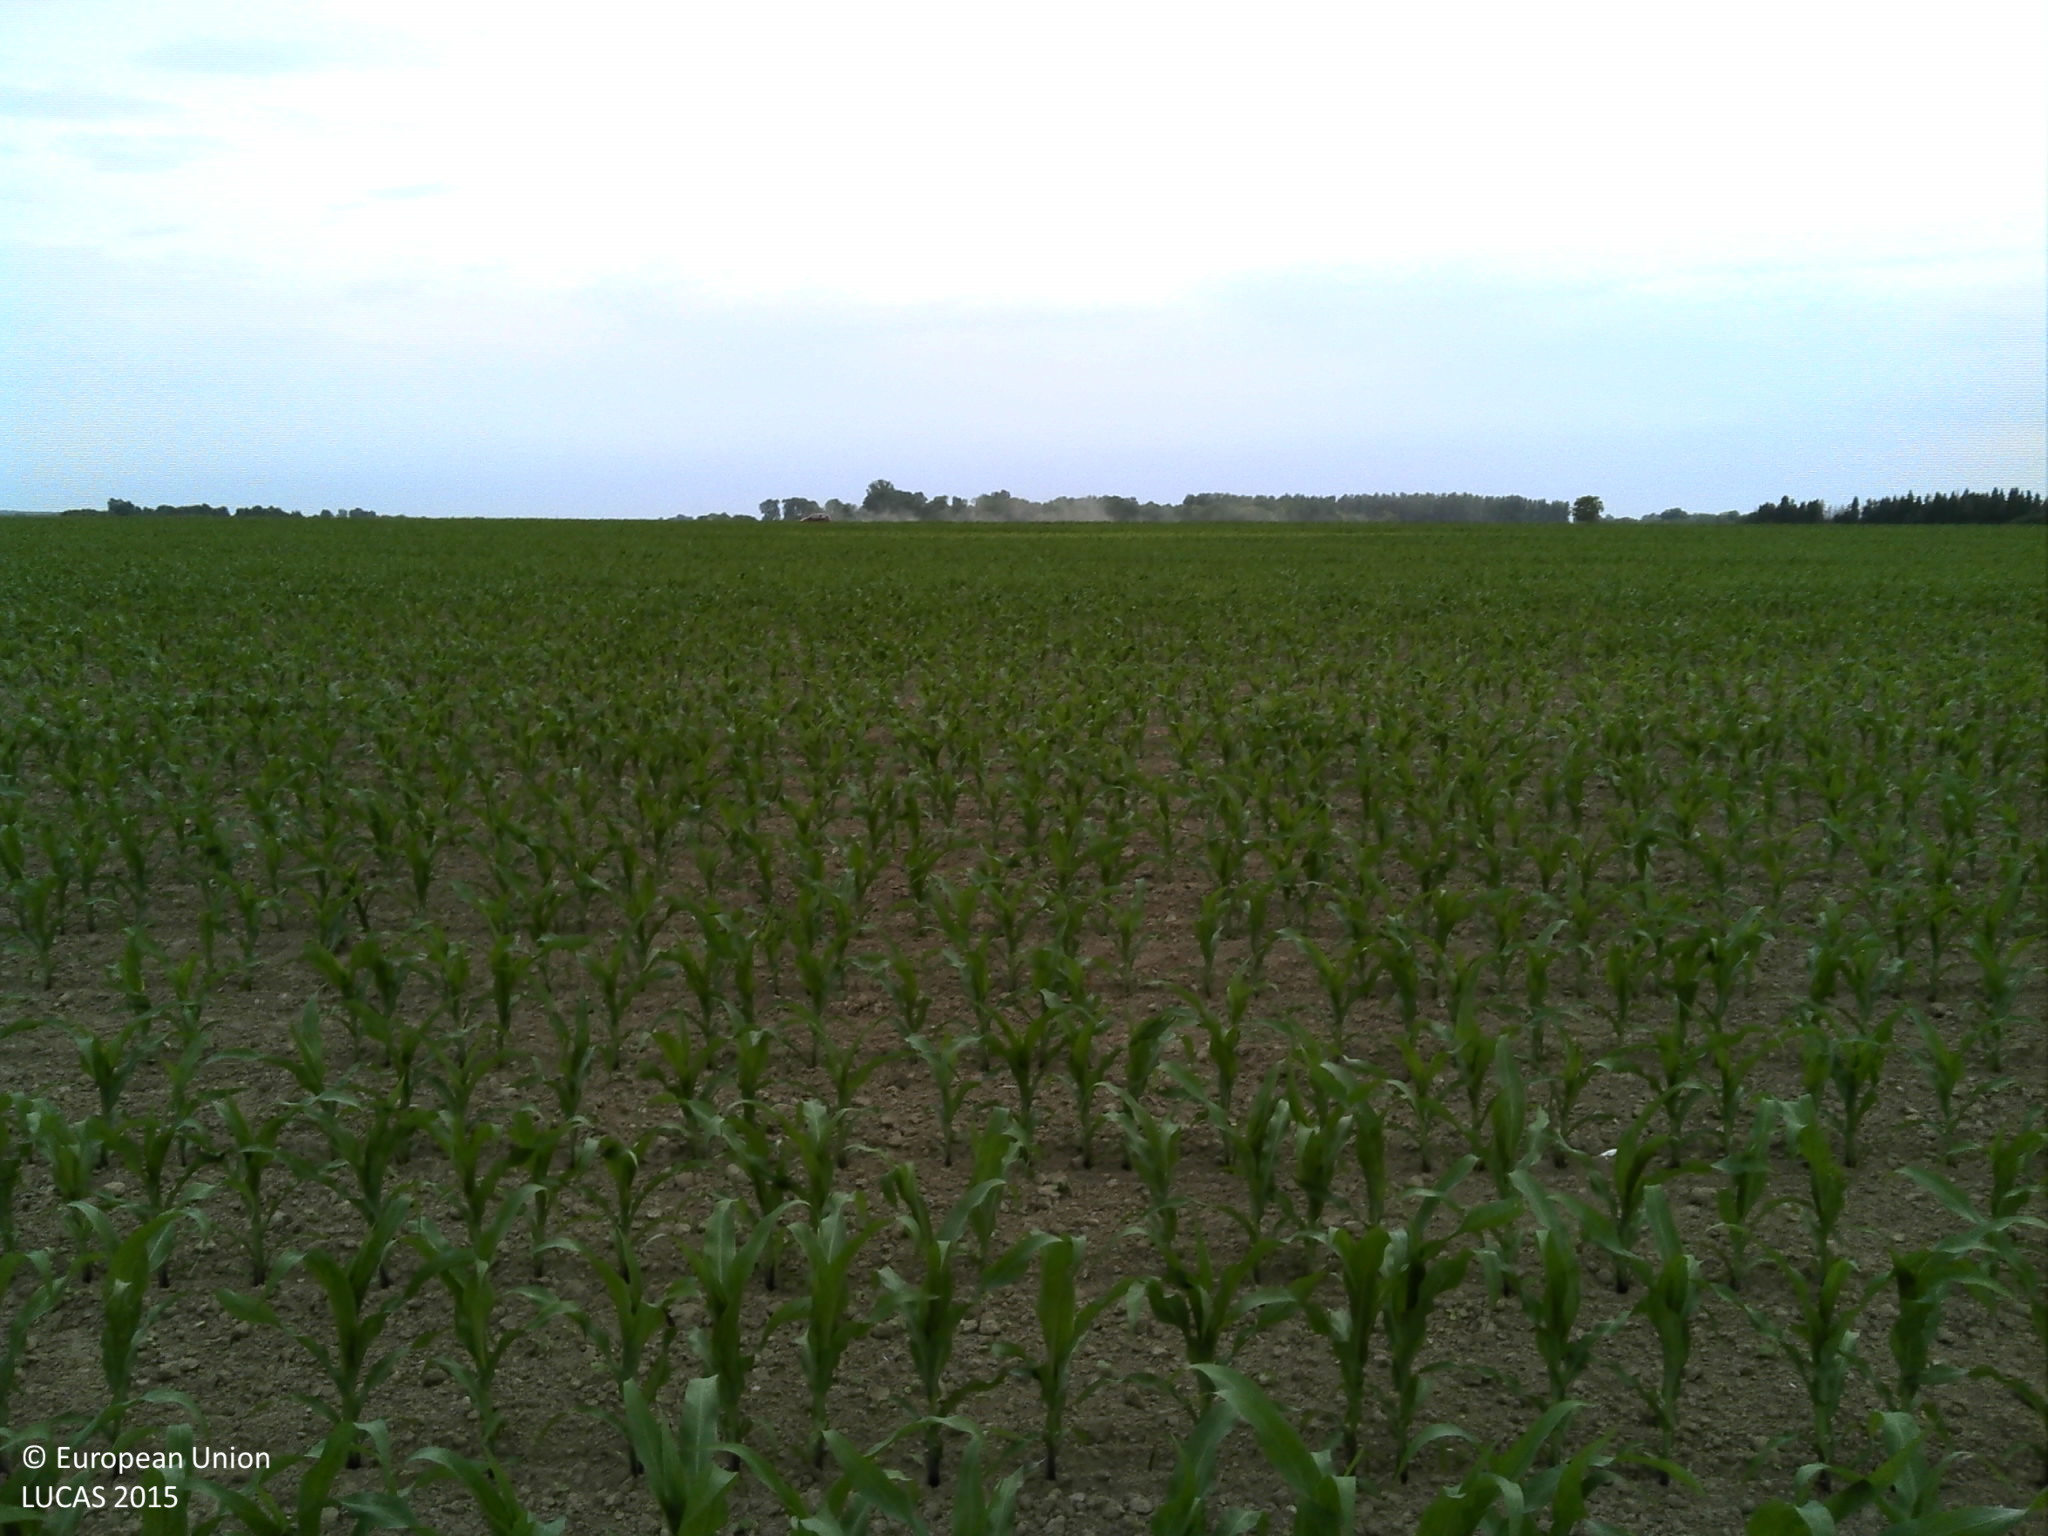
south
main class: Cropland
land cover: Maize
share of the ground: 25 - 50 %
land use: Agriculture (excluding fallow land and kitchen gardens)
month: May
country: HR
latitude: 45.5438
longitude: 18.4722
